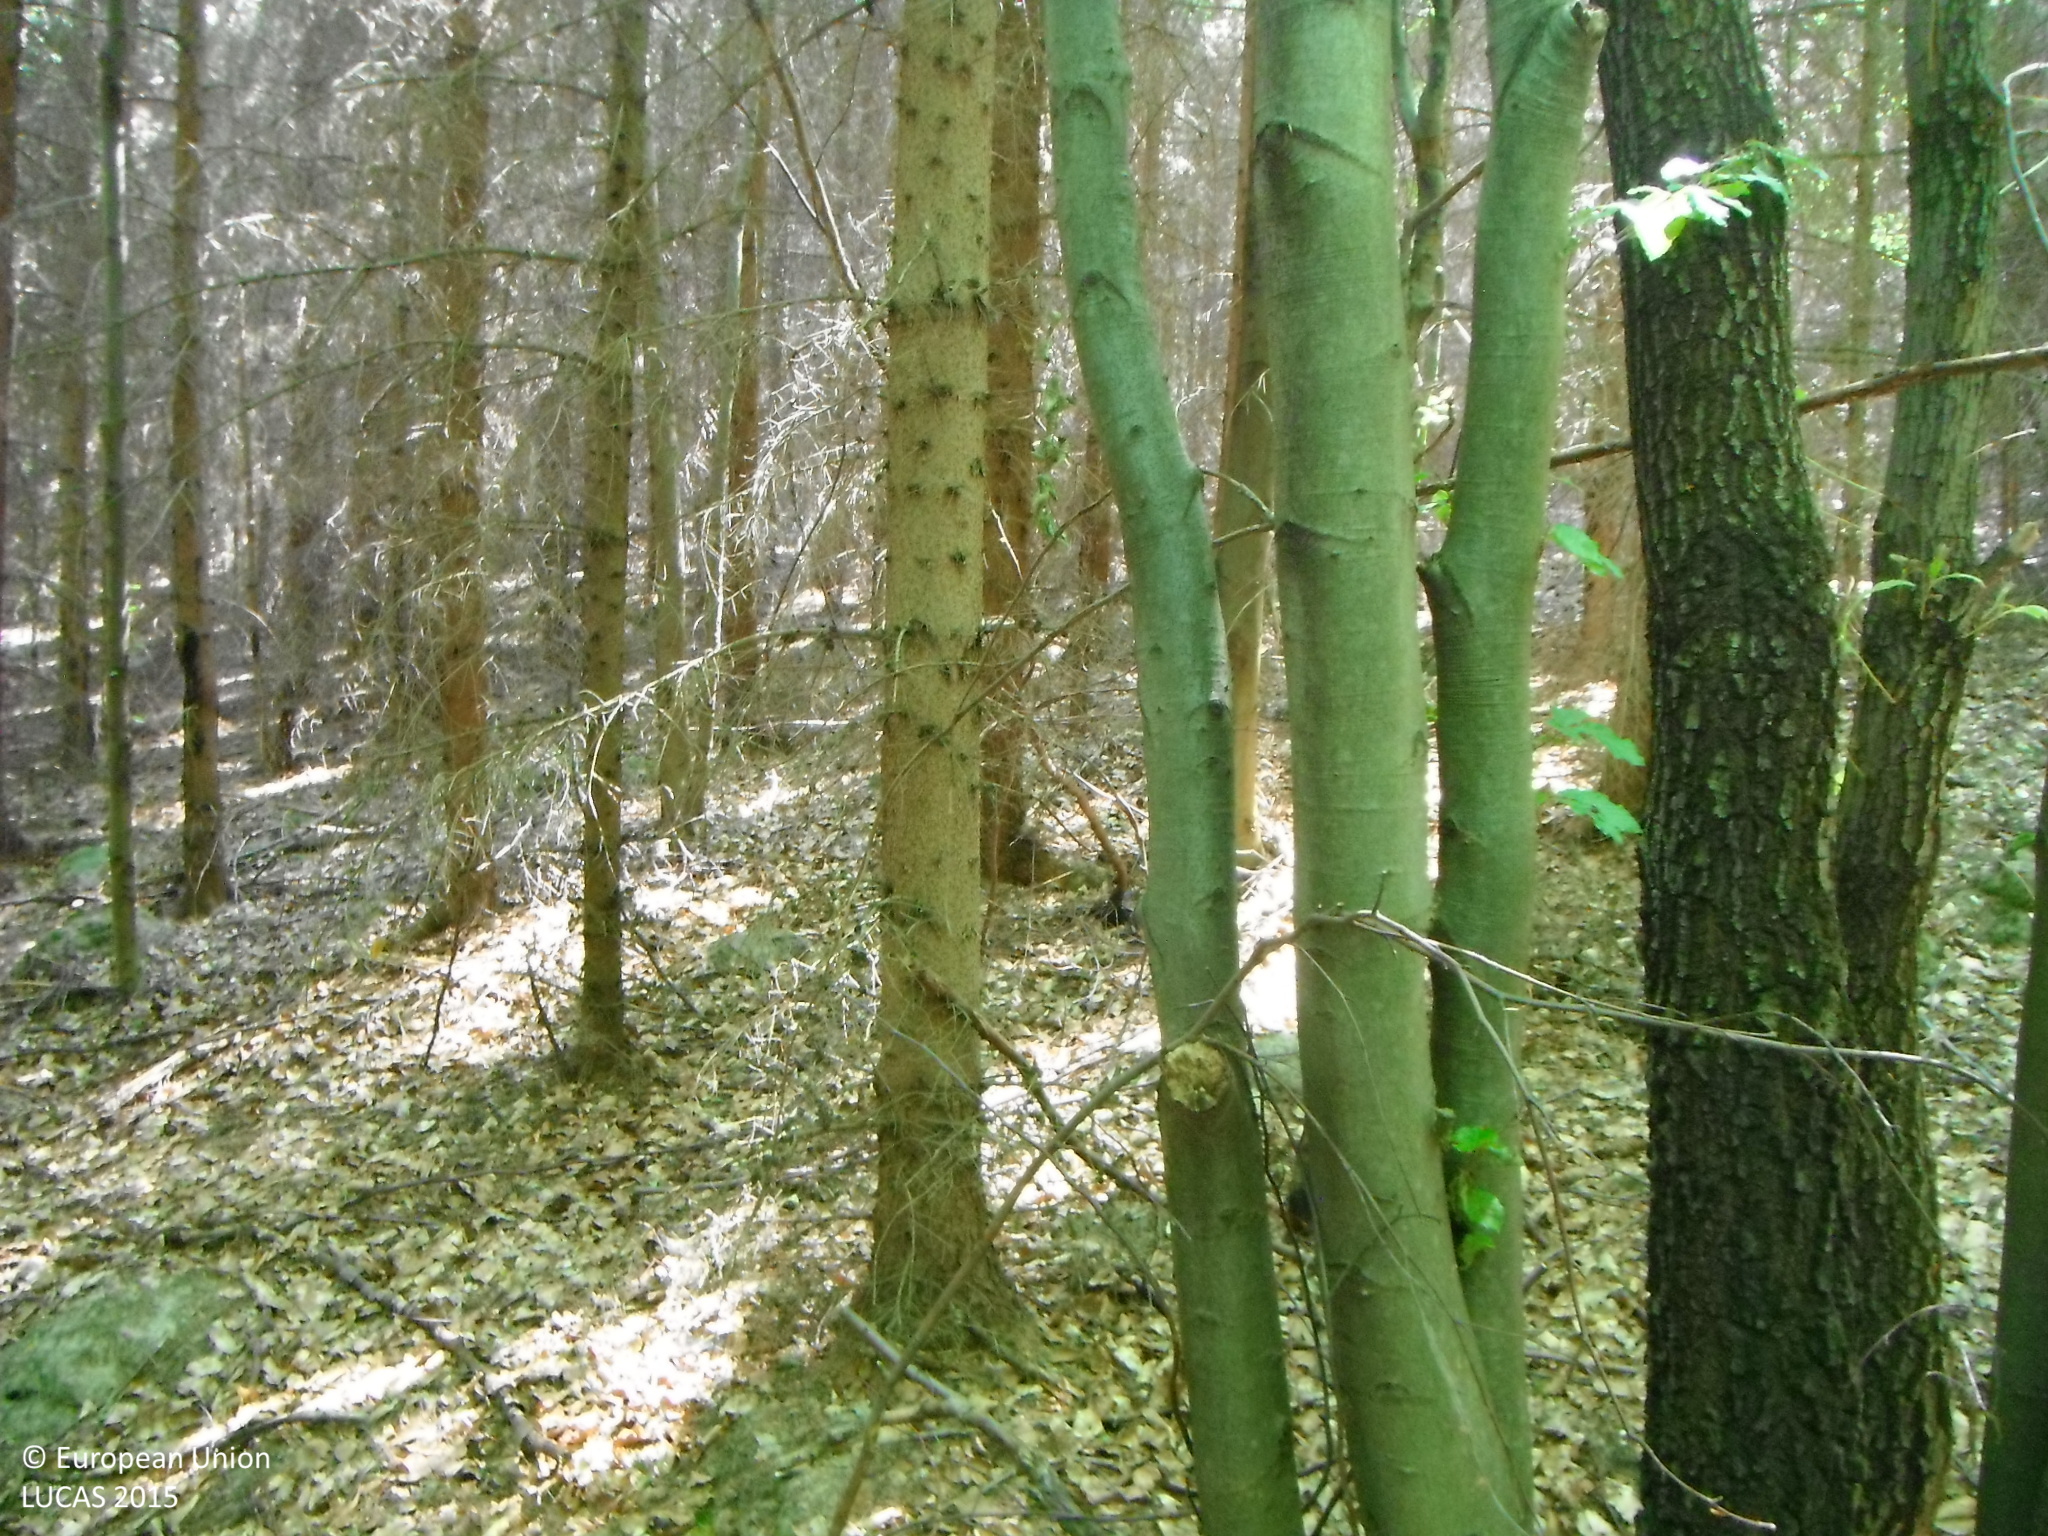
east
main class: Woodland
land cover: Spruce dominated mixed woodland
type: alpine coniferous forest
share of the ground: > 75 %
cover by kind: coniferous forest trees 50 %, broadleaved forest trees 50 %
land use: Forestry
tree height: > 5 m
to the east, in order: Spruce dominated mixed woodland; Other mixed woodland; Broadleaved woodland
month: July
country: SK
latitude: 48.5115
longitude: 19.1592
